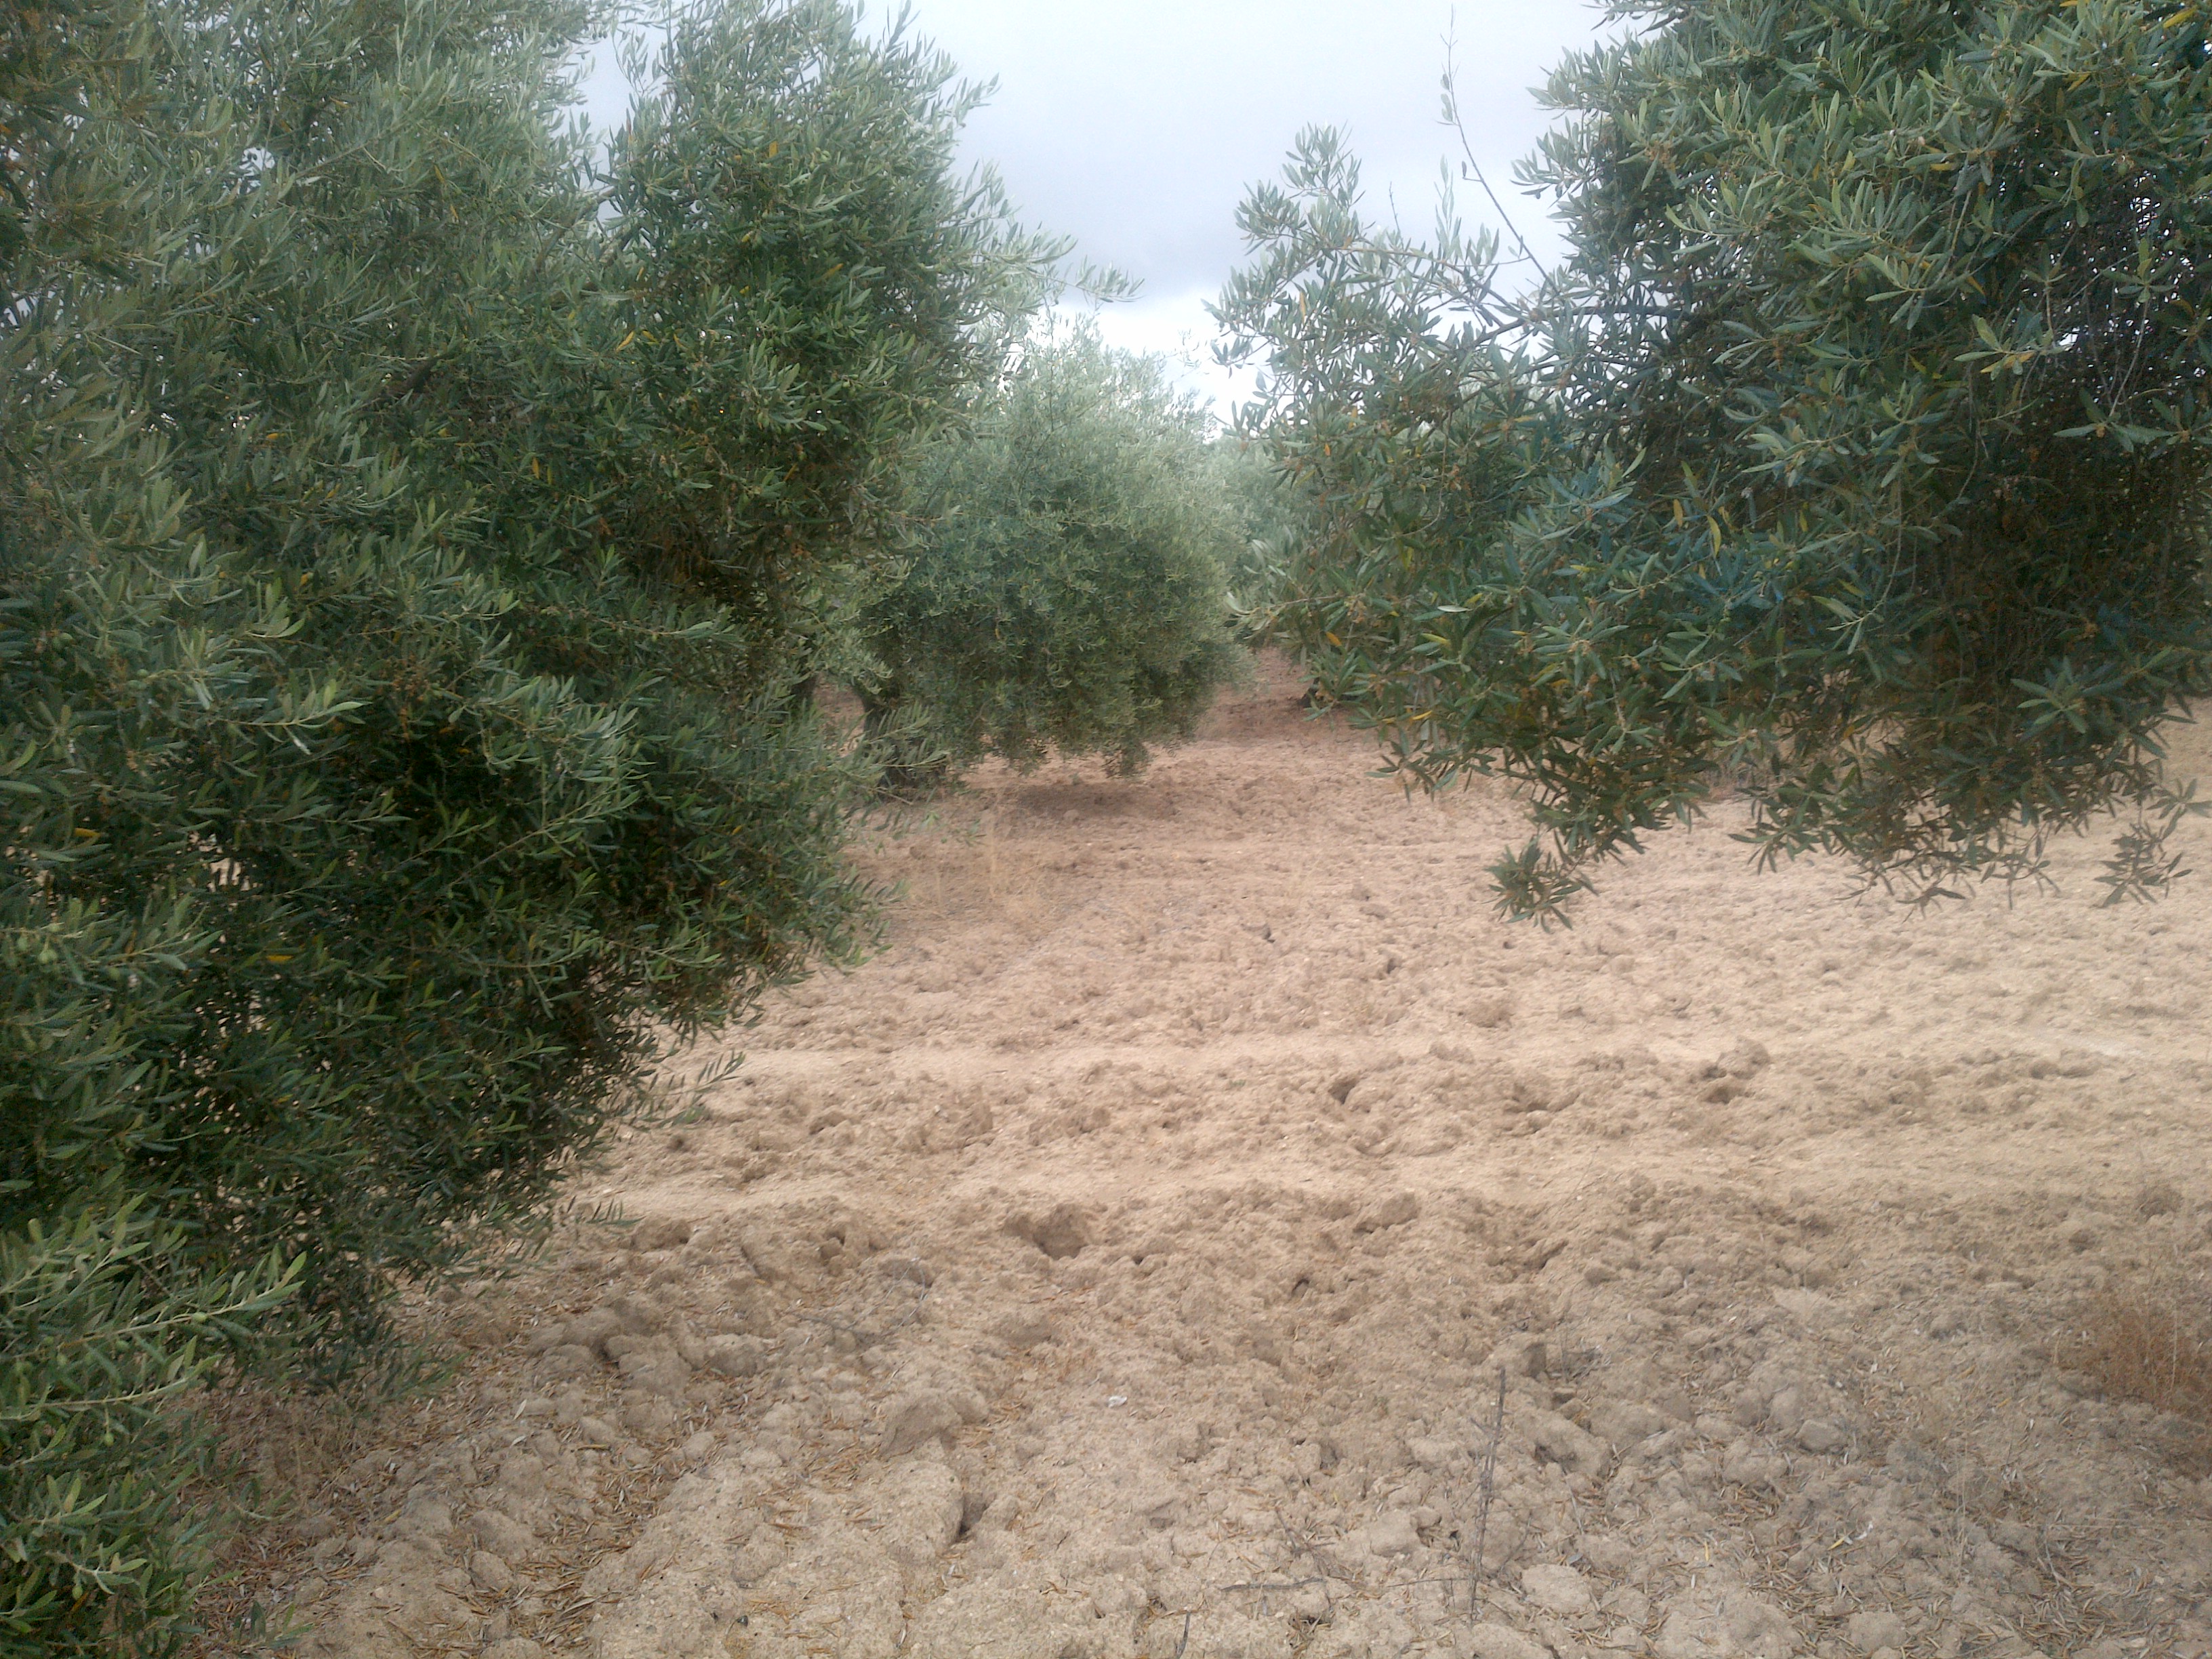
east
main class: Cropland
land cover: Olive groves
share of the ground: 50 - 75 %
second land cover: Other bare soil
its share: > 75 %
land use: Agriculture (excluding fallow land and kitchen gardens)
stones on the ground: 10 - 25 %
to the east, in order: Olive groves; Other bare soil; Tracks; Olive groves
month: June
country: ES
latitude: 37.9307
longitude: -4.2873
